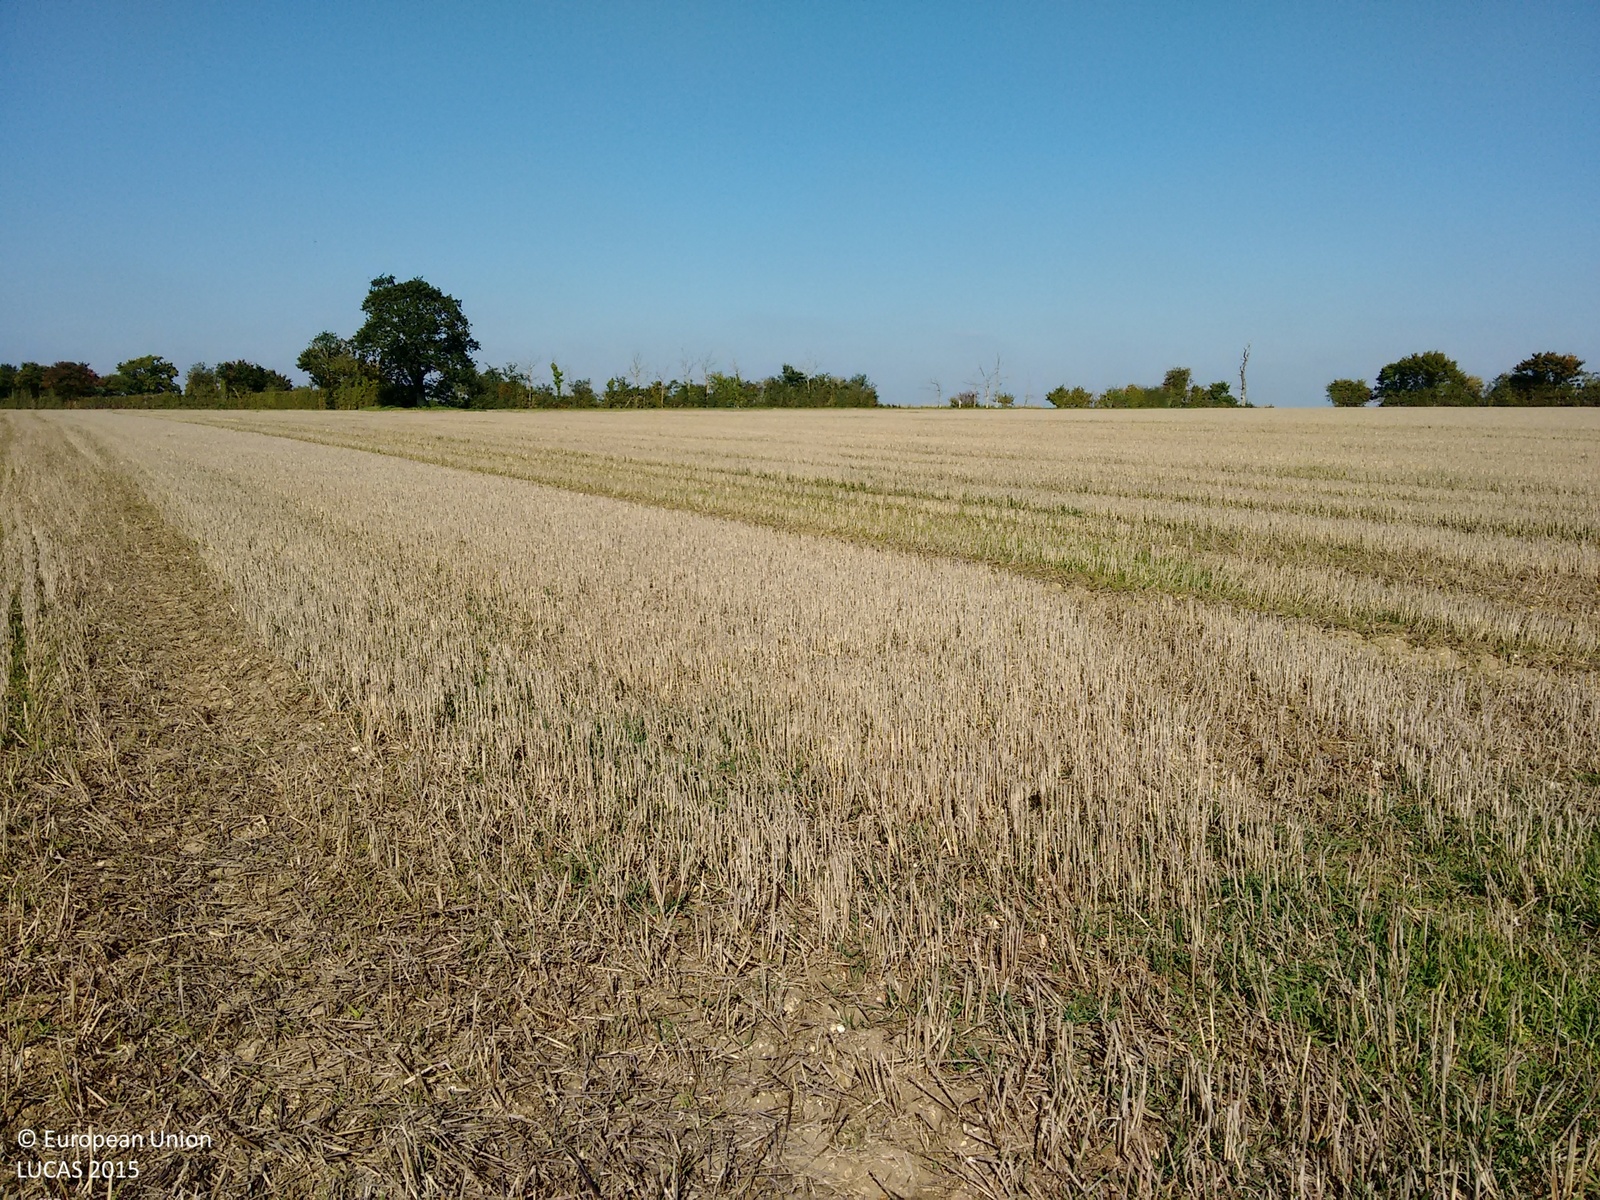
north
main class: Cropland
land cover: Common wheat
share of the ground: > 75 %
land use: Agriculture (excluding fallow land and kitchen gardens)
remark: Harvested field
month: October
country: GB
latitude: 52.3566
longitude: 0.9464
